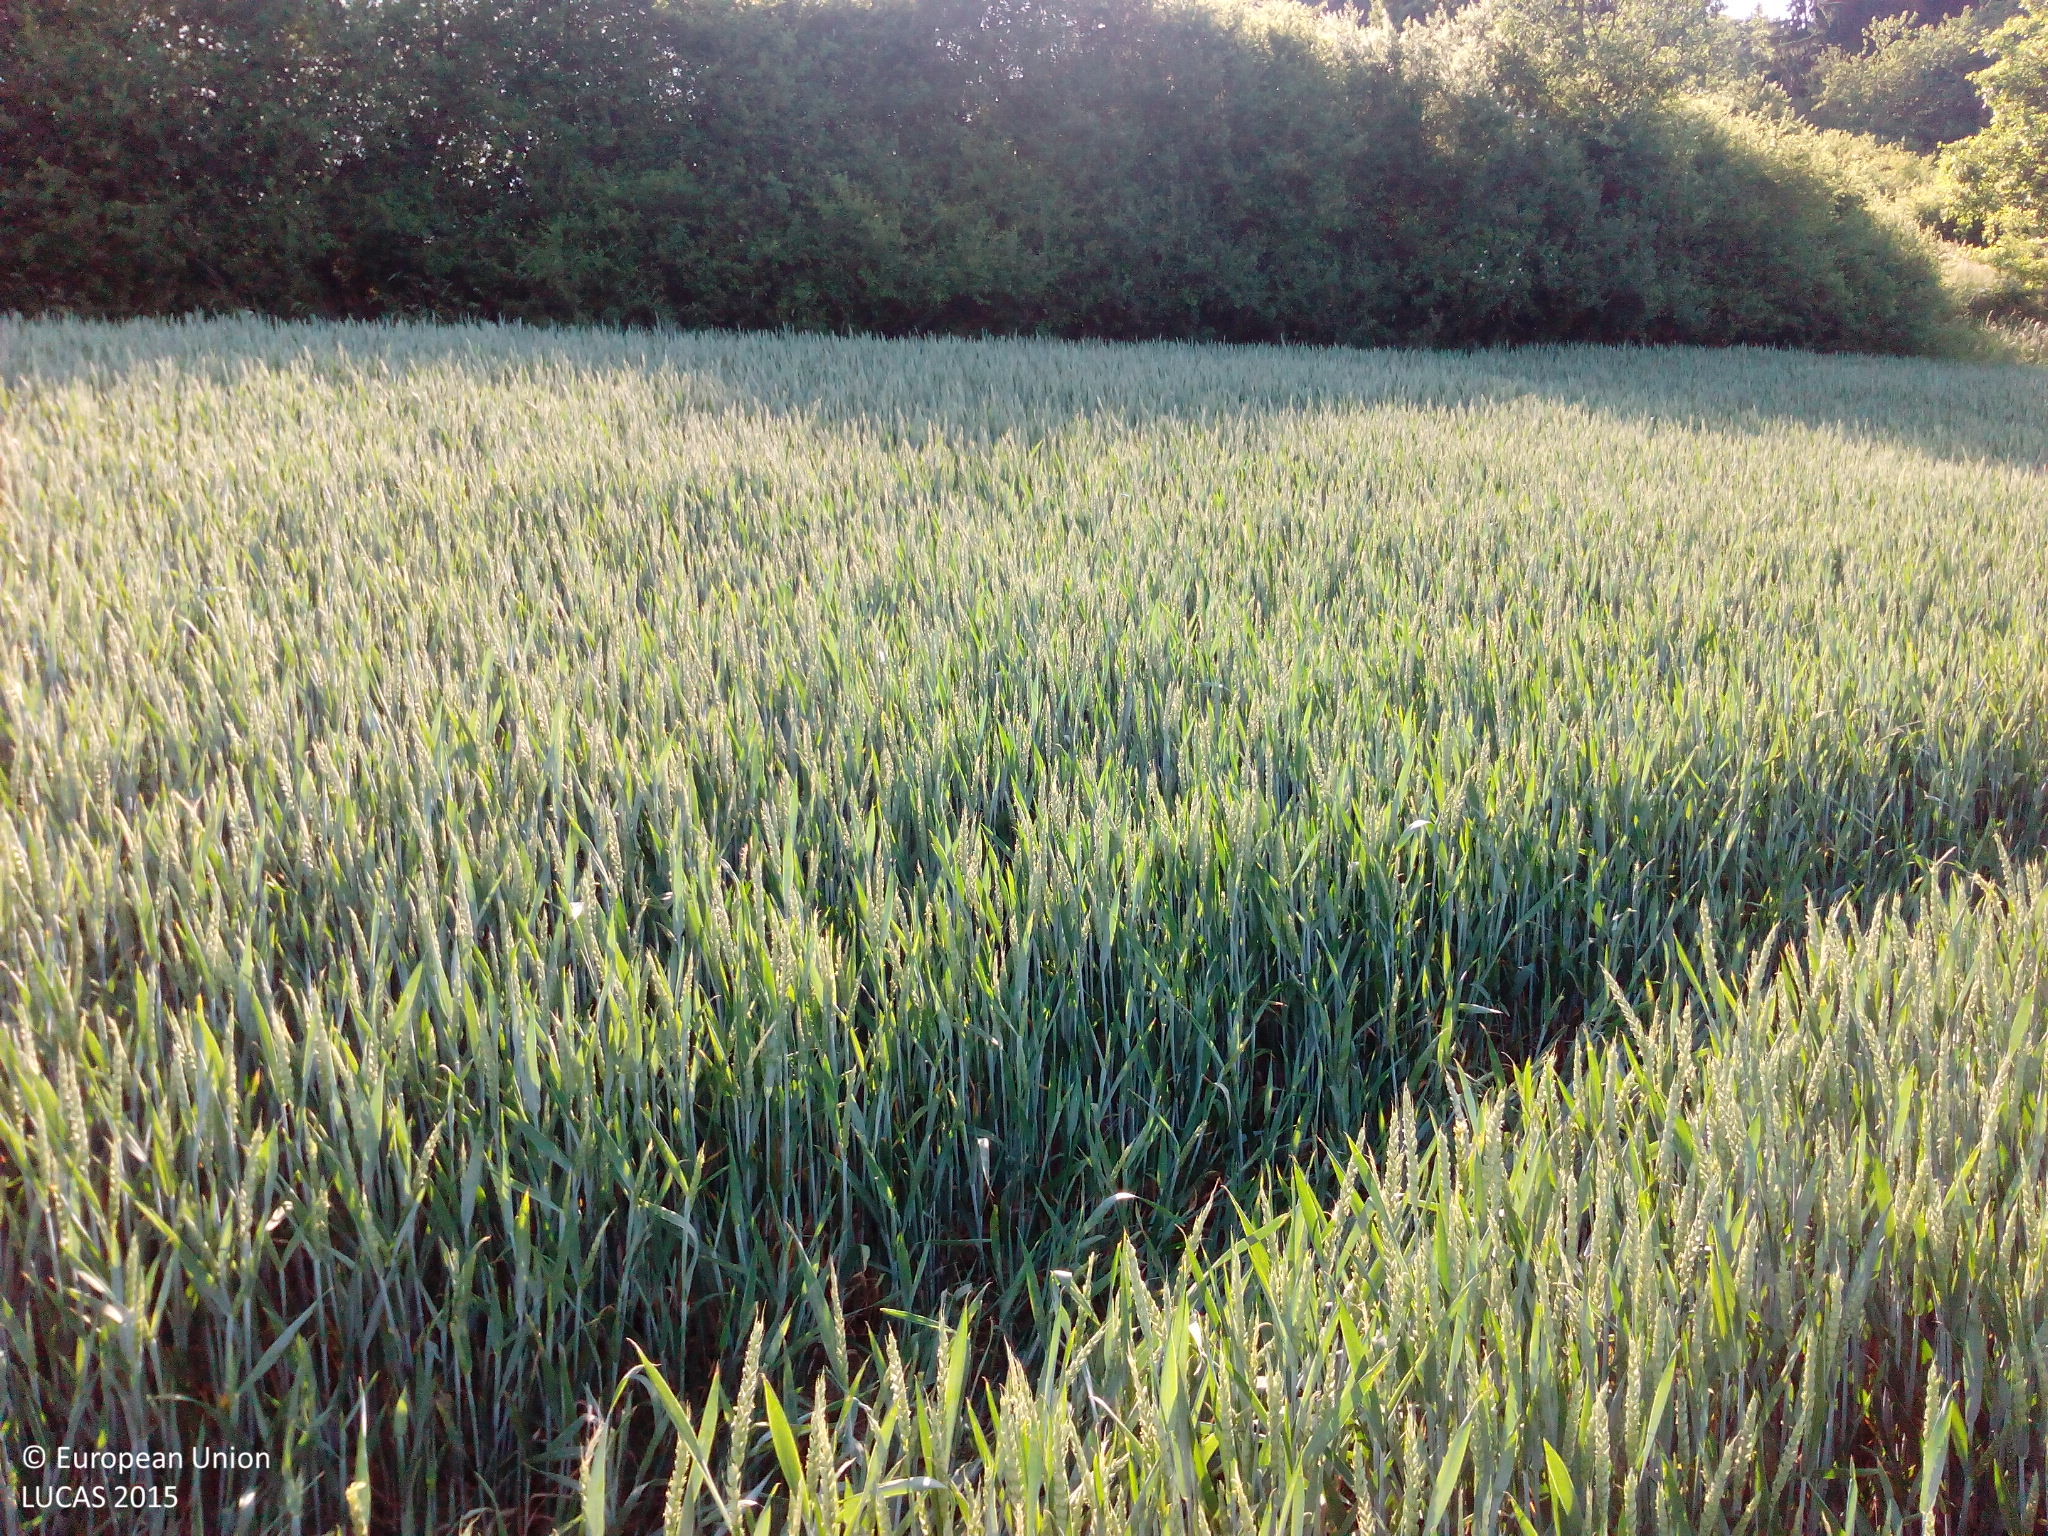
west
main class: Cropland
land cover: Common wheat
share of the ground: > 75 %
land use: Agriculture (excluding fallow land and kitchen gardens)
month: June
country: DE
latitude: 50.1511
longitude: 8.1390
